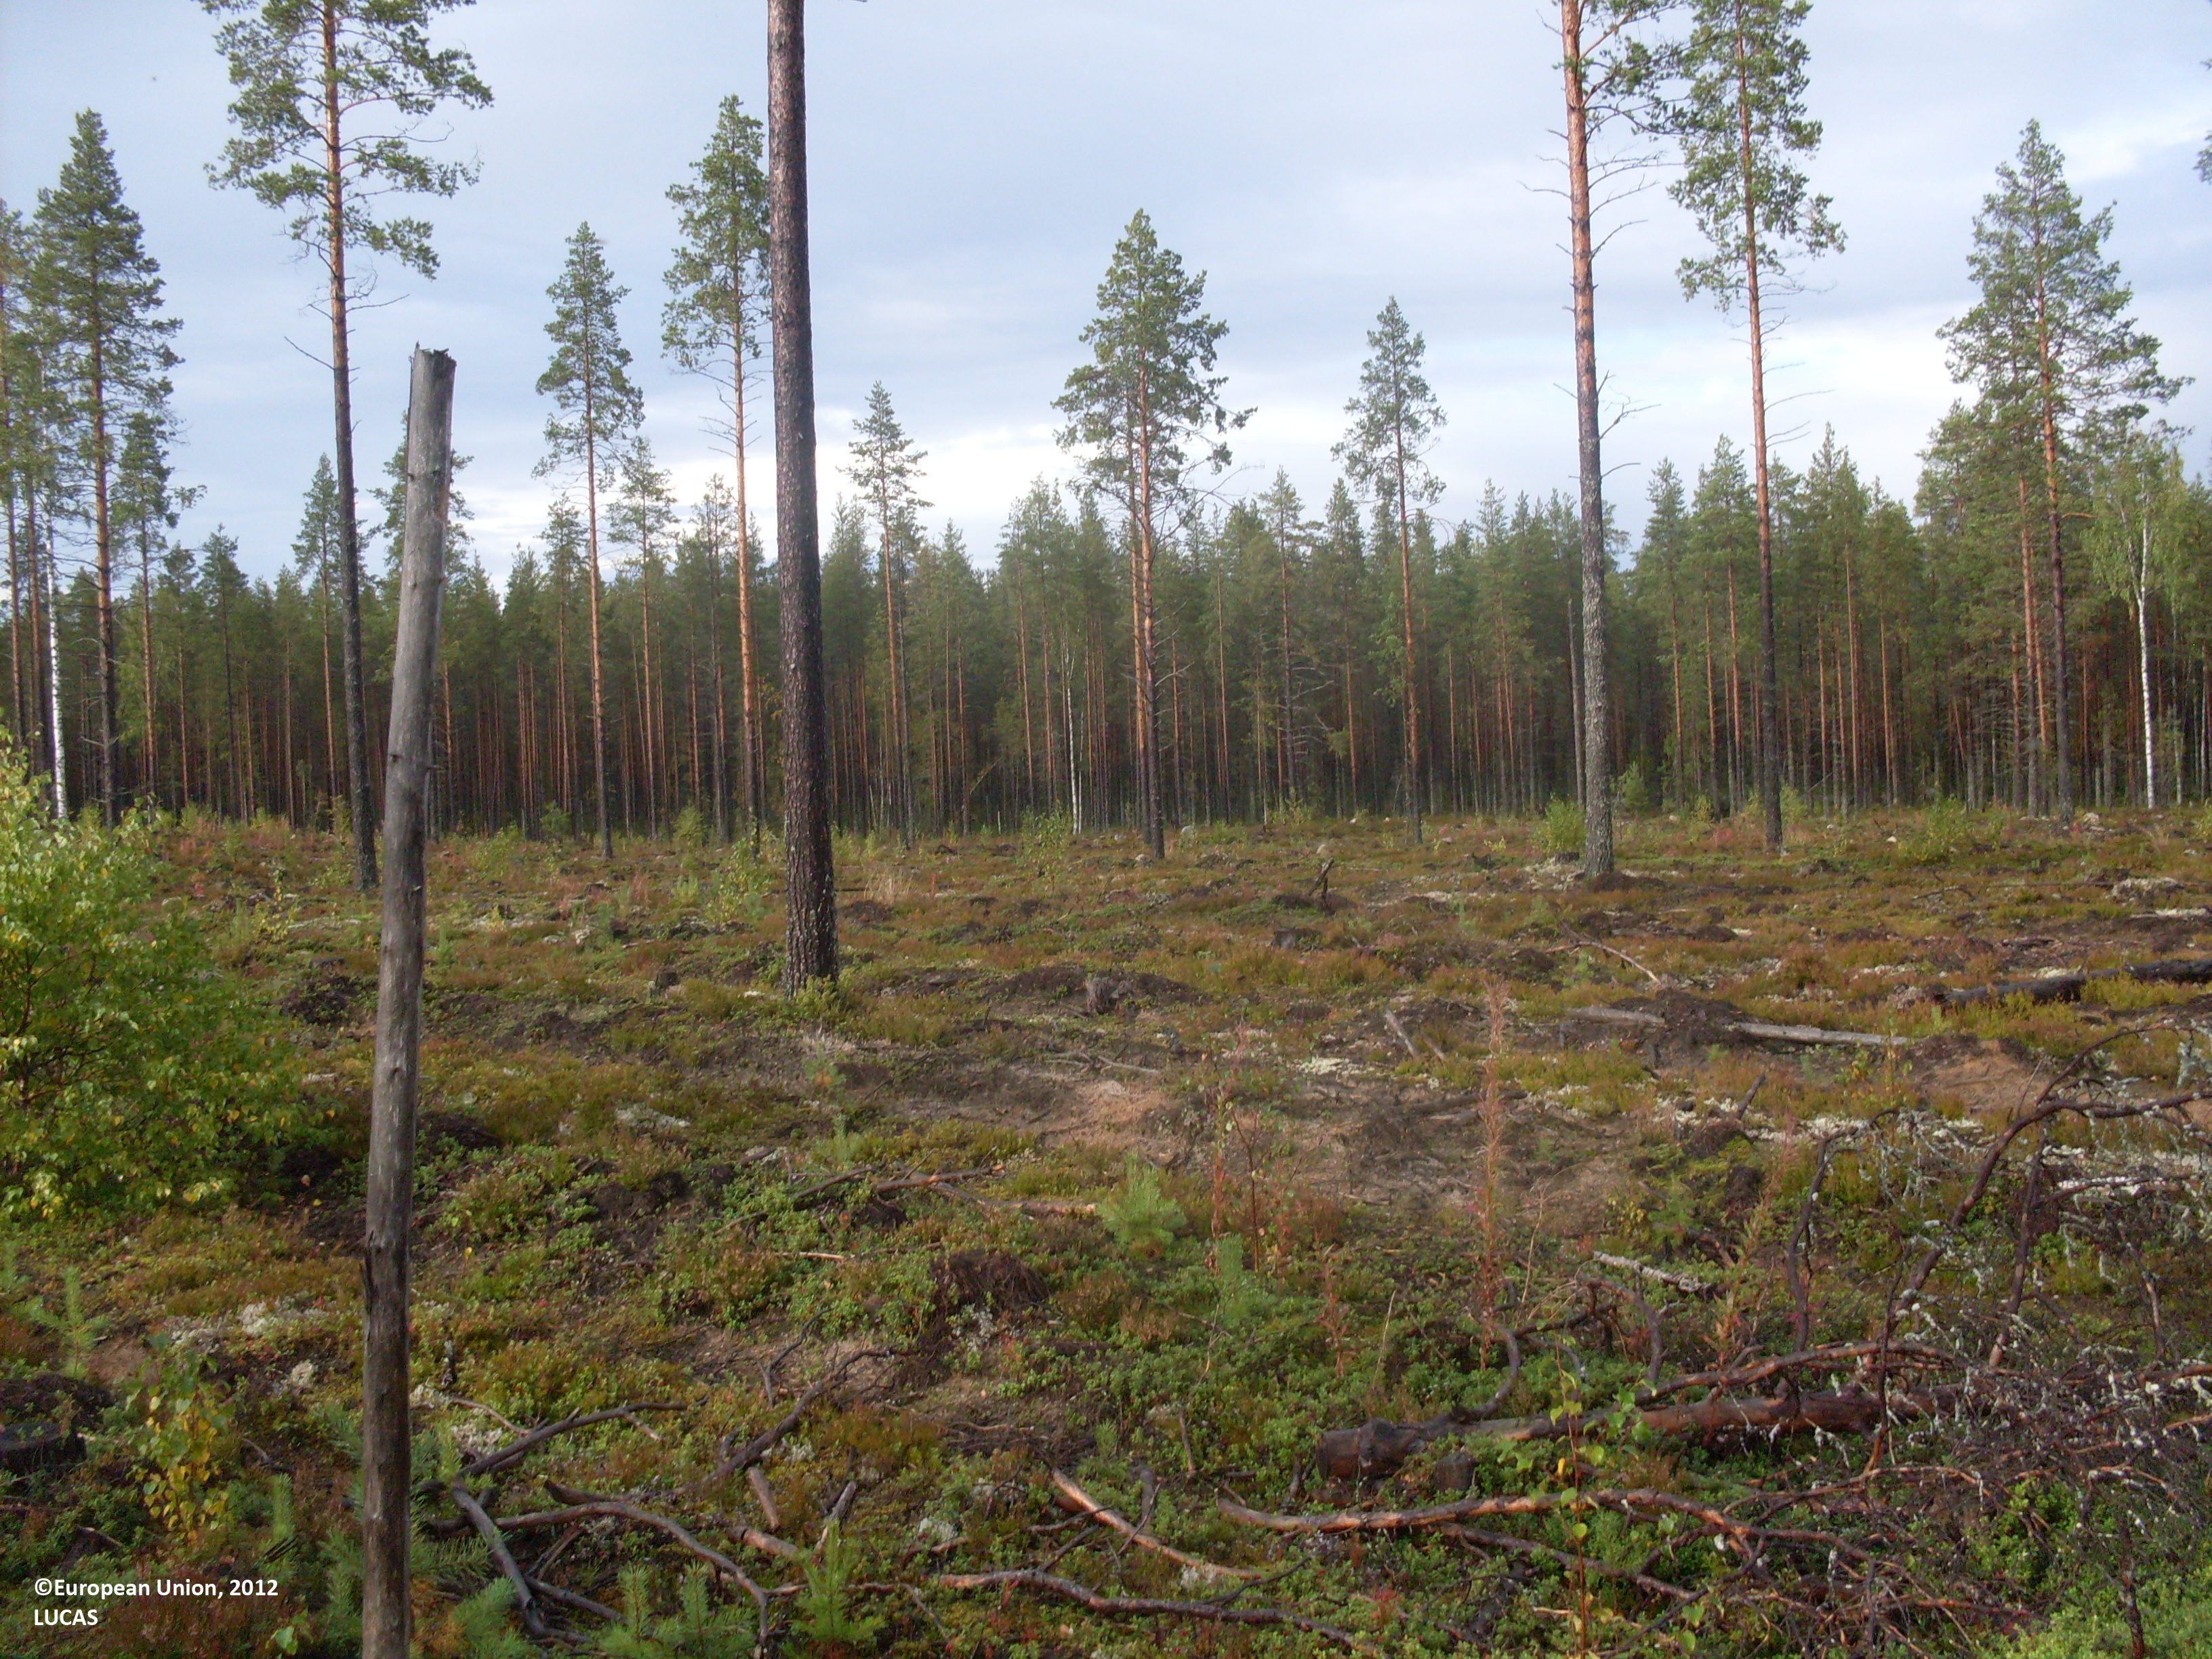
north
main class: Woodland
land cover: Pine dominated coniferous woodland
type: boreal forest
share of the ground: 10 - 25 %
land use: Forestry
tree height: < 5 m
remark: Nursery
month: September
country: FI
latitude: 64.1570
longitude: 29.8264
